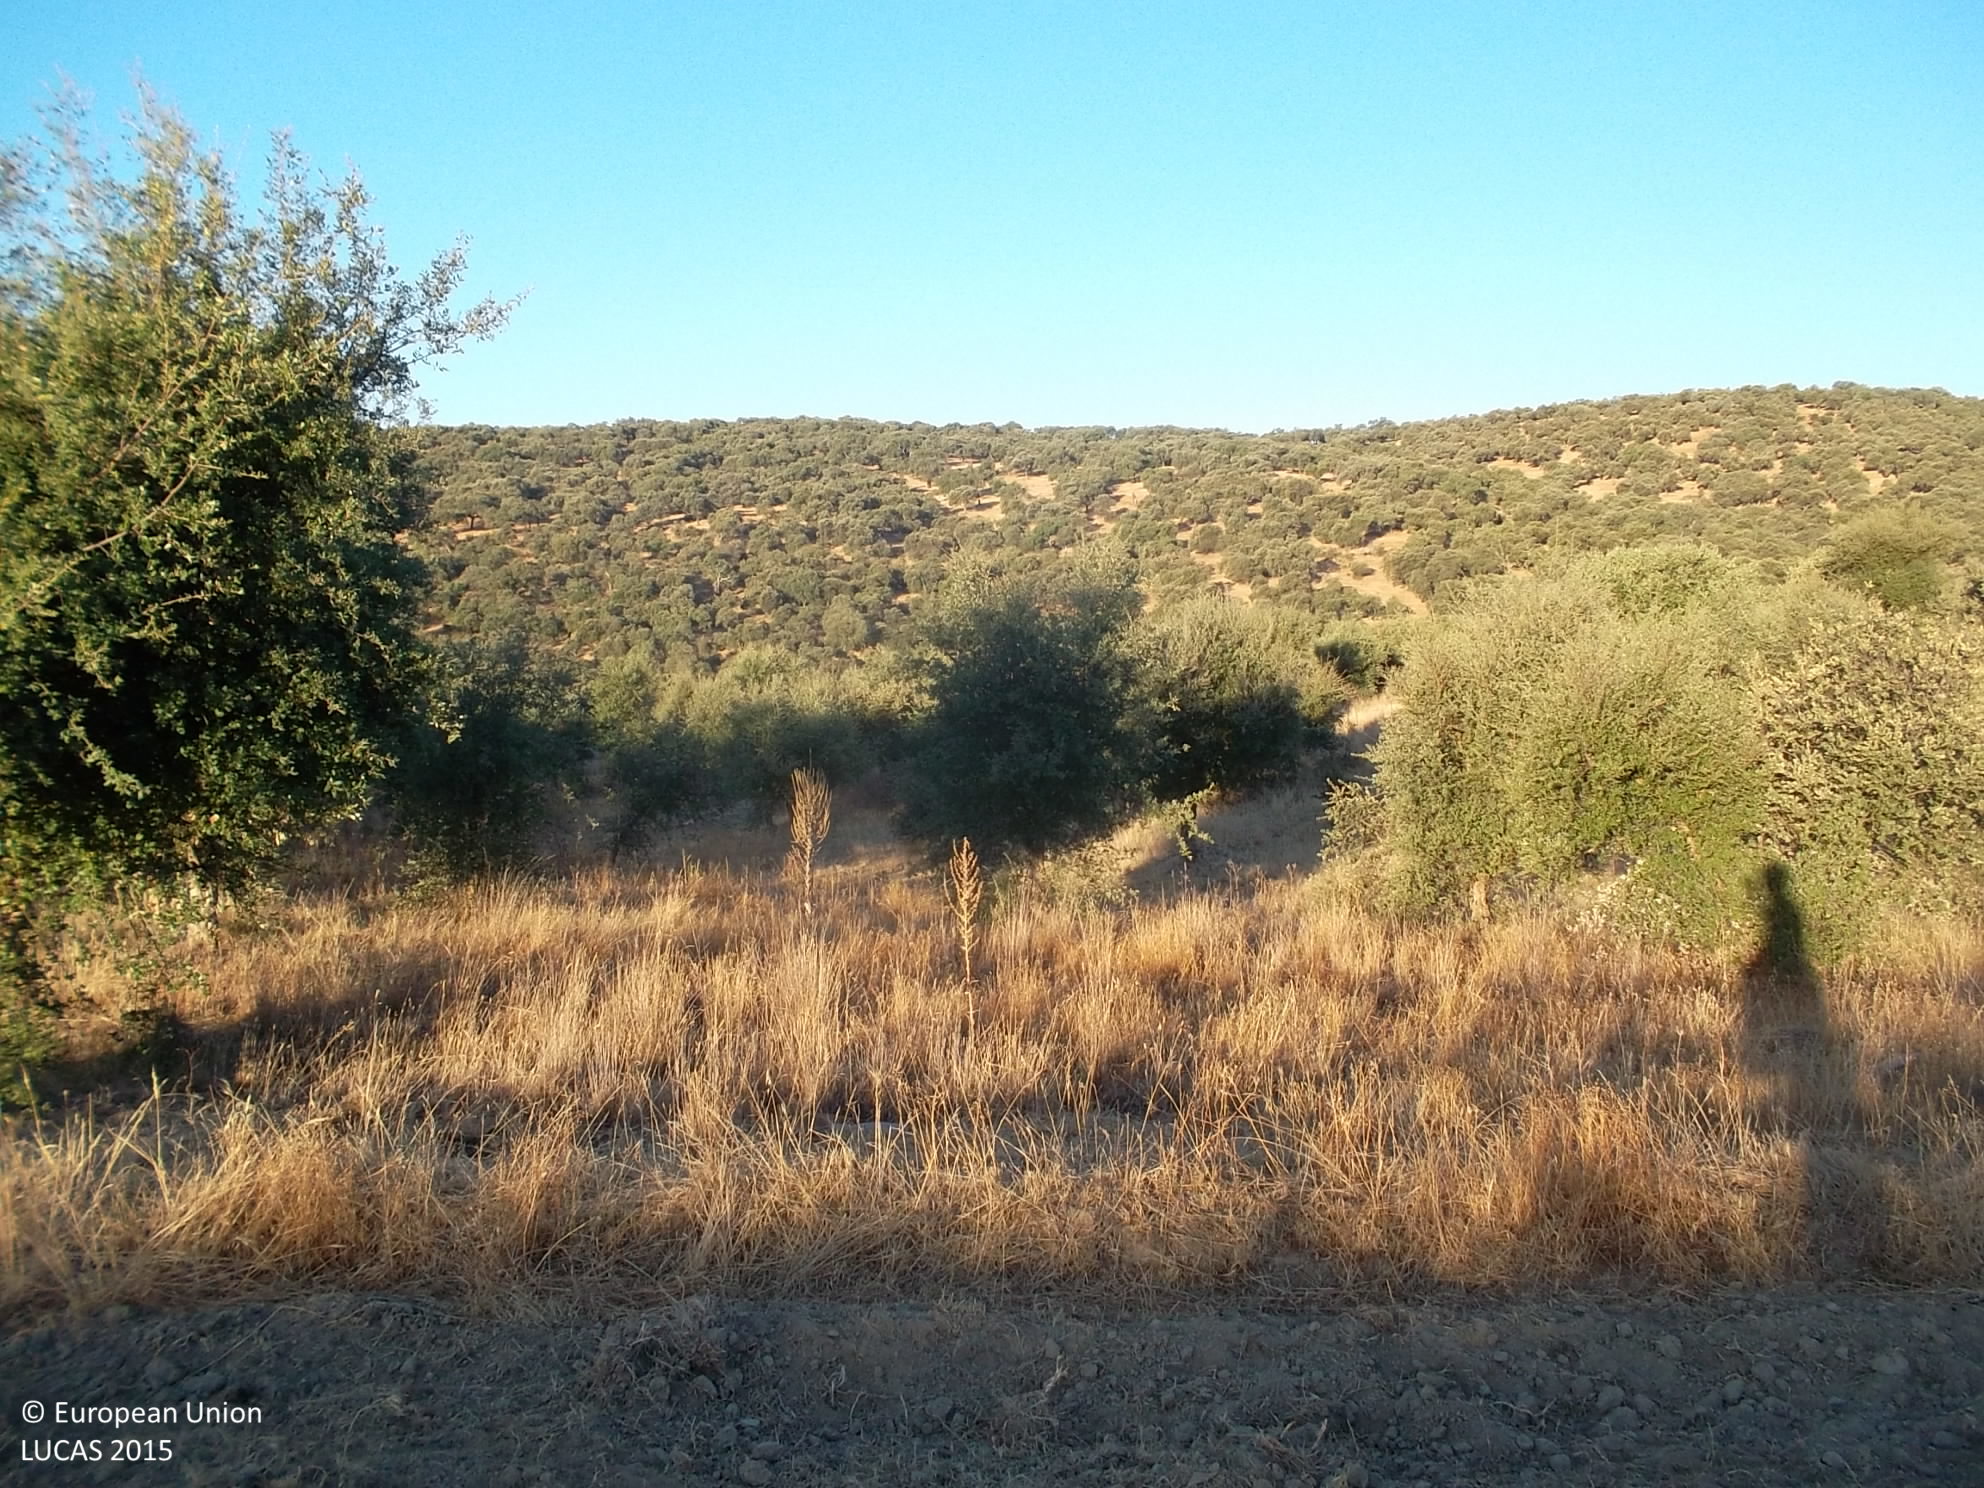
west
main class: Woodland
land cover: Broadleaved woodland
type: broadleaved evergreen forest
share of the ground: 50 - 75 %
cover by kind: broadleaved forest trees 50 %, herbaceous plants 50 %
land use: Forestry
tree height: < 5 m
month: August
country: ES
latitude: 38.4350
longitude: -6.6083
